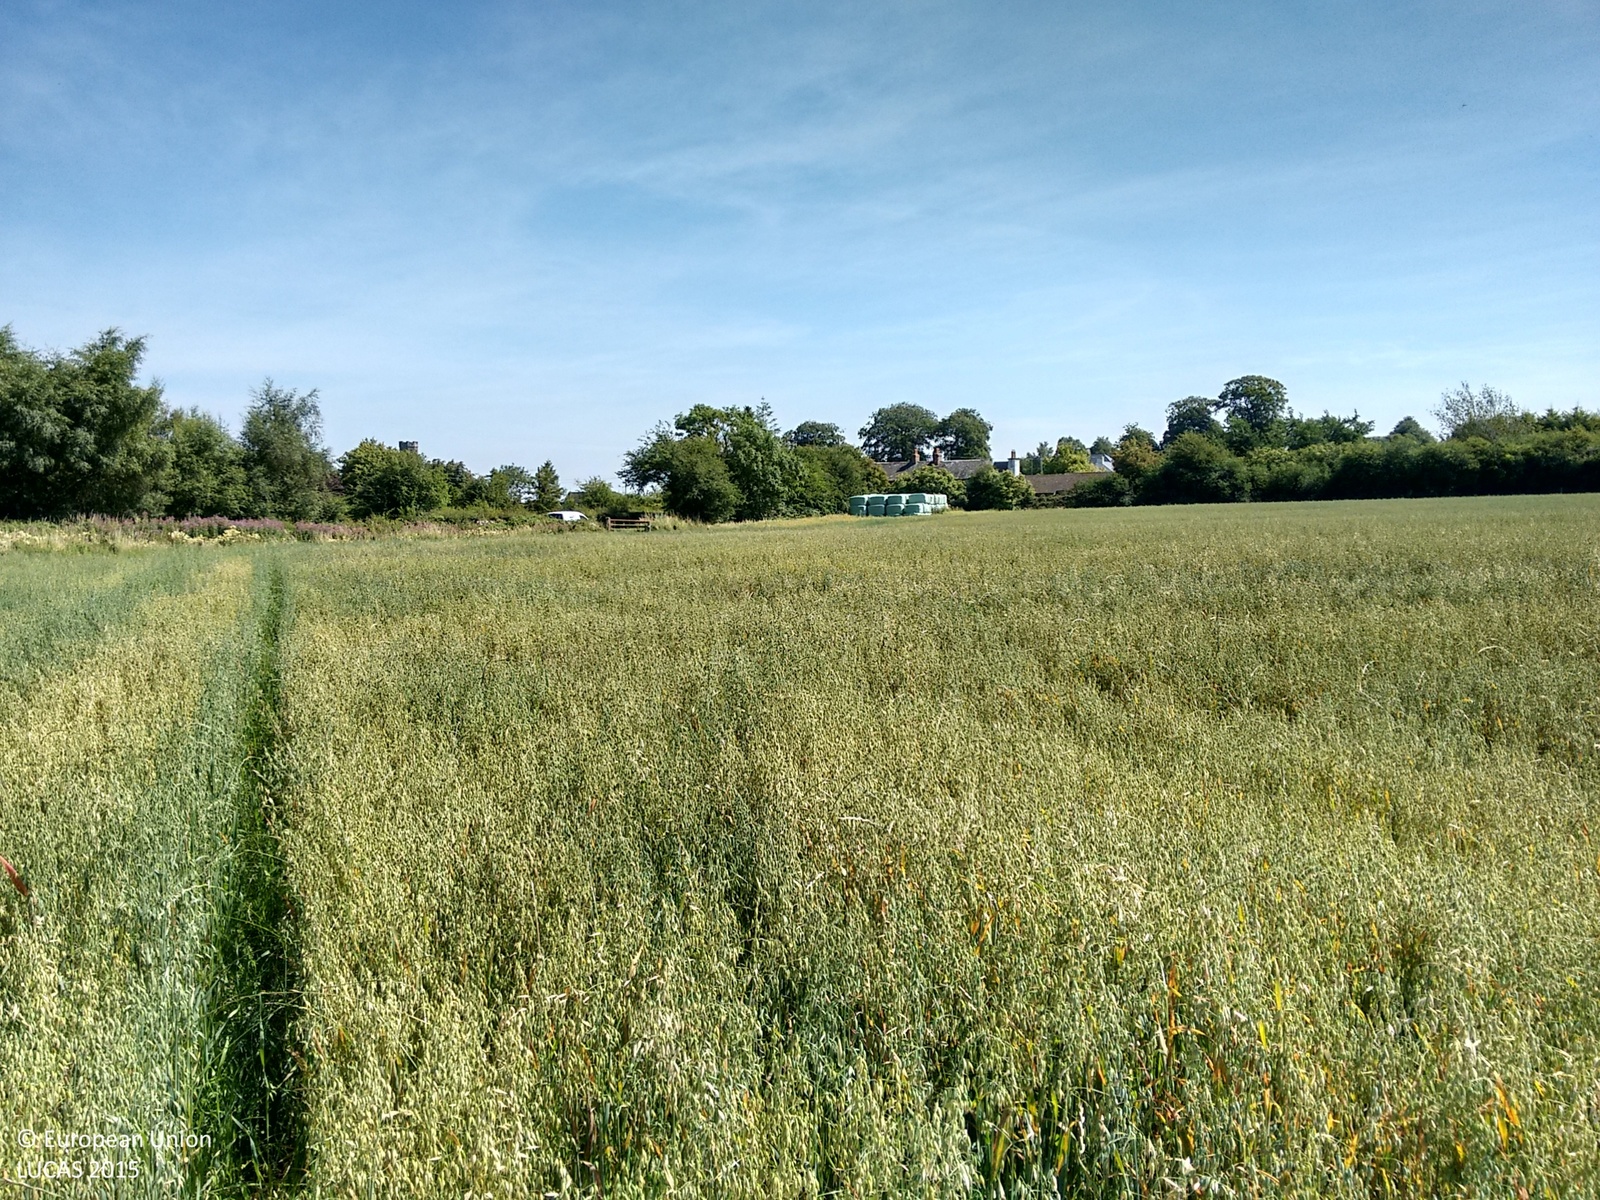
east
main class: Cropland
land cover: Oats
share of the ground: > 75 %
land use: Agriculture (excluding fallow land and kitchen gardens)
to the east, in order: Oats; Managed hedges; Artificial constructions in urban areas; Grassland without tree/shrub cover; Managed hedges; Grass margins; Paved roads, cycling and walking lanes; Grass margins; Managed hedges; Electric lines; Fences; Grassland without tree/shrub cover; Artificial constructions in urban areas; Grassland without tree/shrub cover
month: August
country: IE
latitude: 52.9210
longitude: -7.5165
